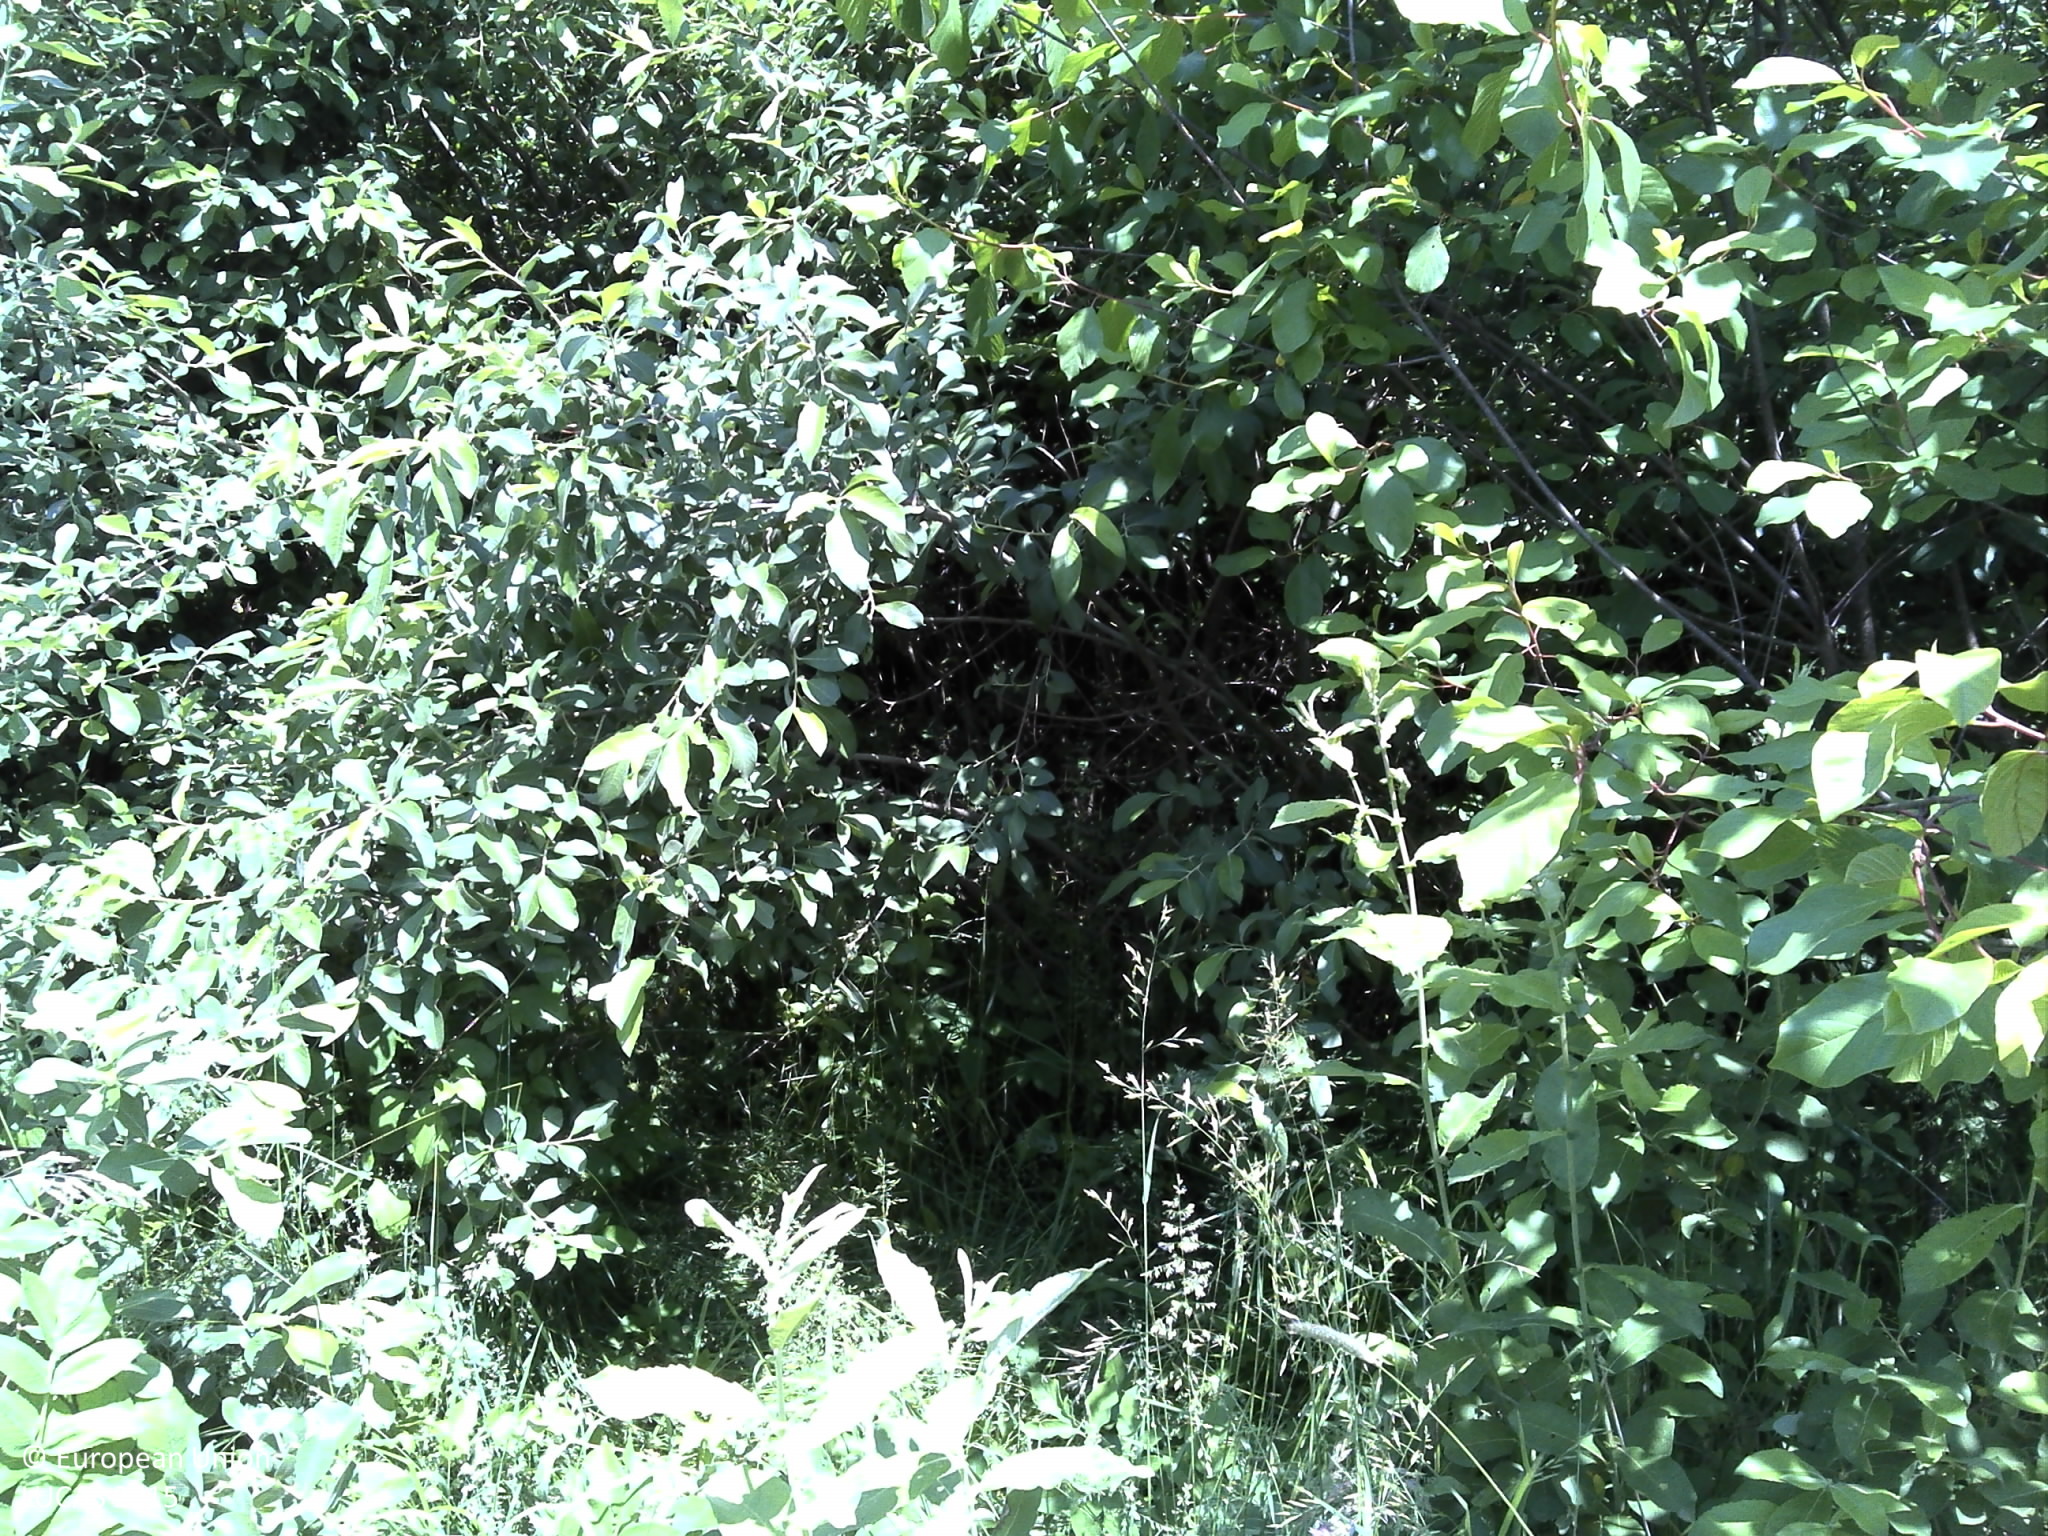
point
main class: Woodland
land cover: Broadleaved woodland
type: mesophytic deciduous forest
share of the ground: > 75 %
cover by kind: broadleaved forest trees 100 %
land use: Forestry
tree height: > 5 m
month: May
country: HR
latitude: 45.3013
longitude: 18.1015
